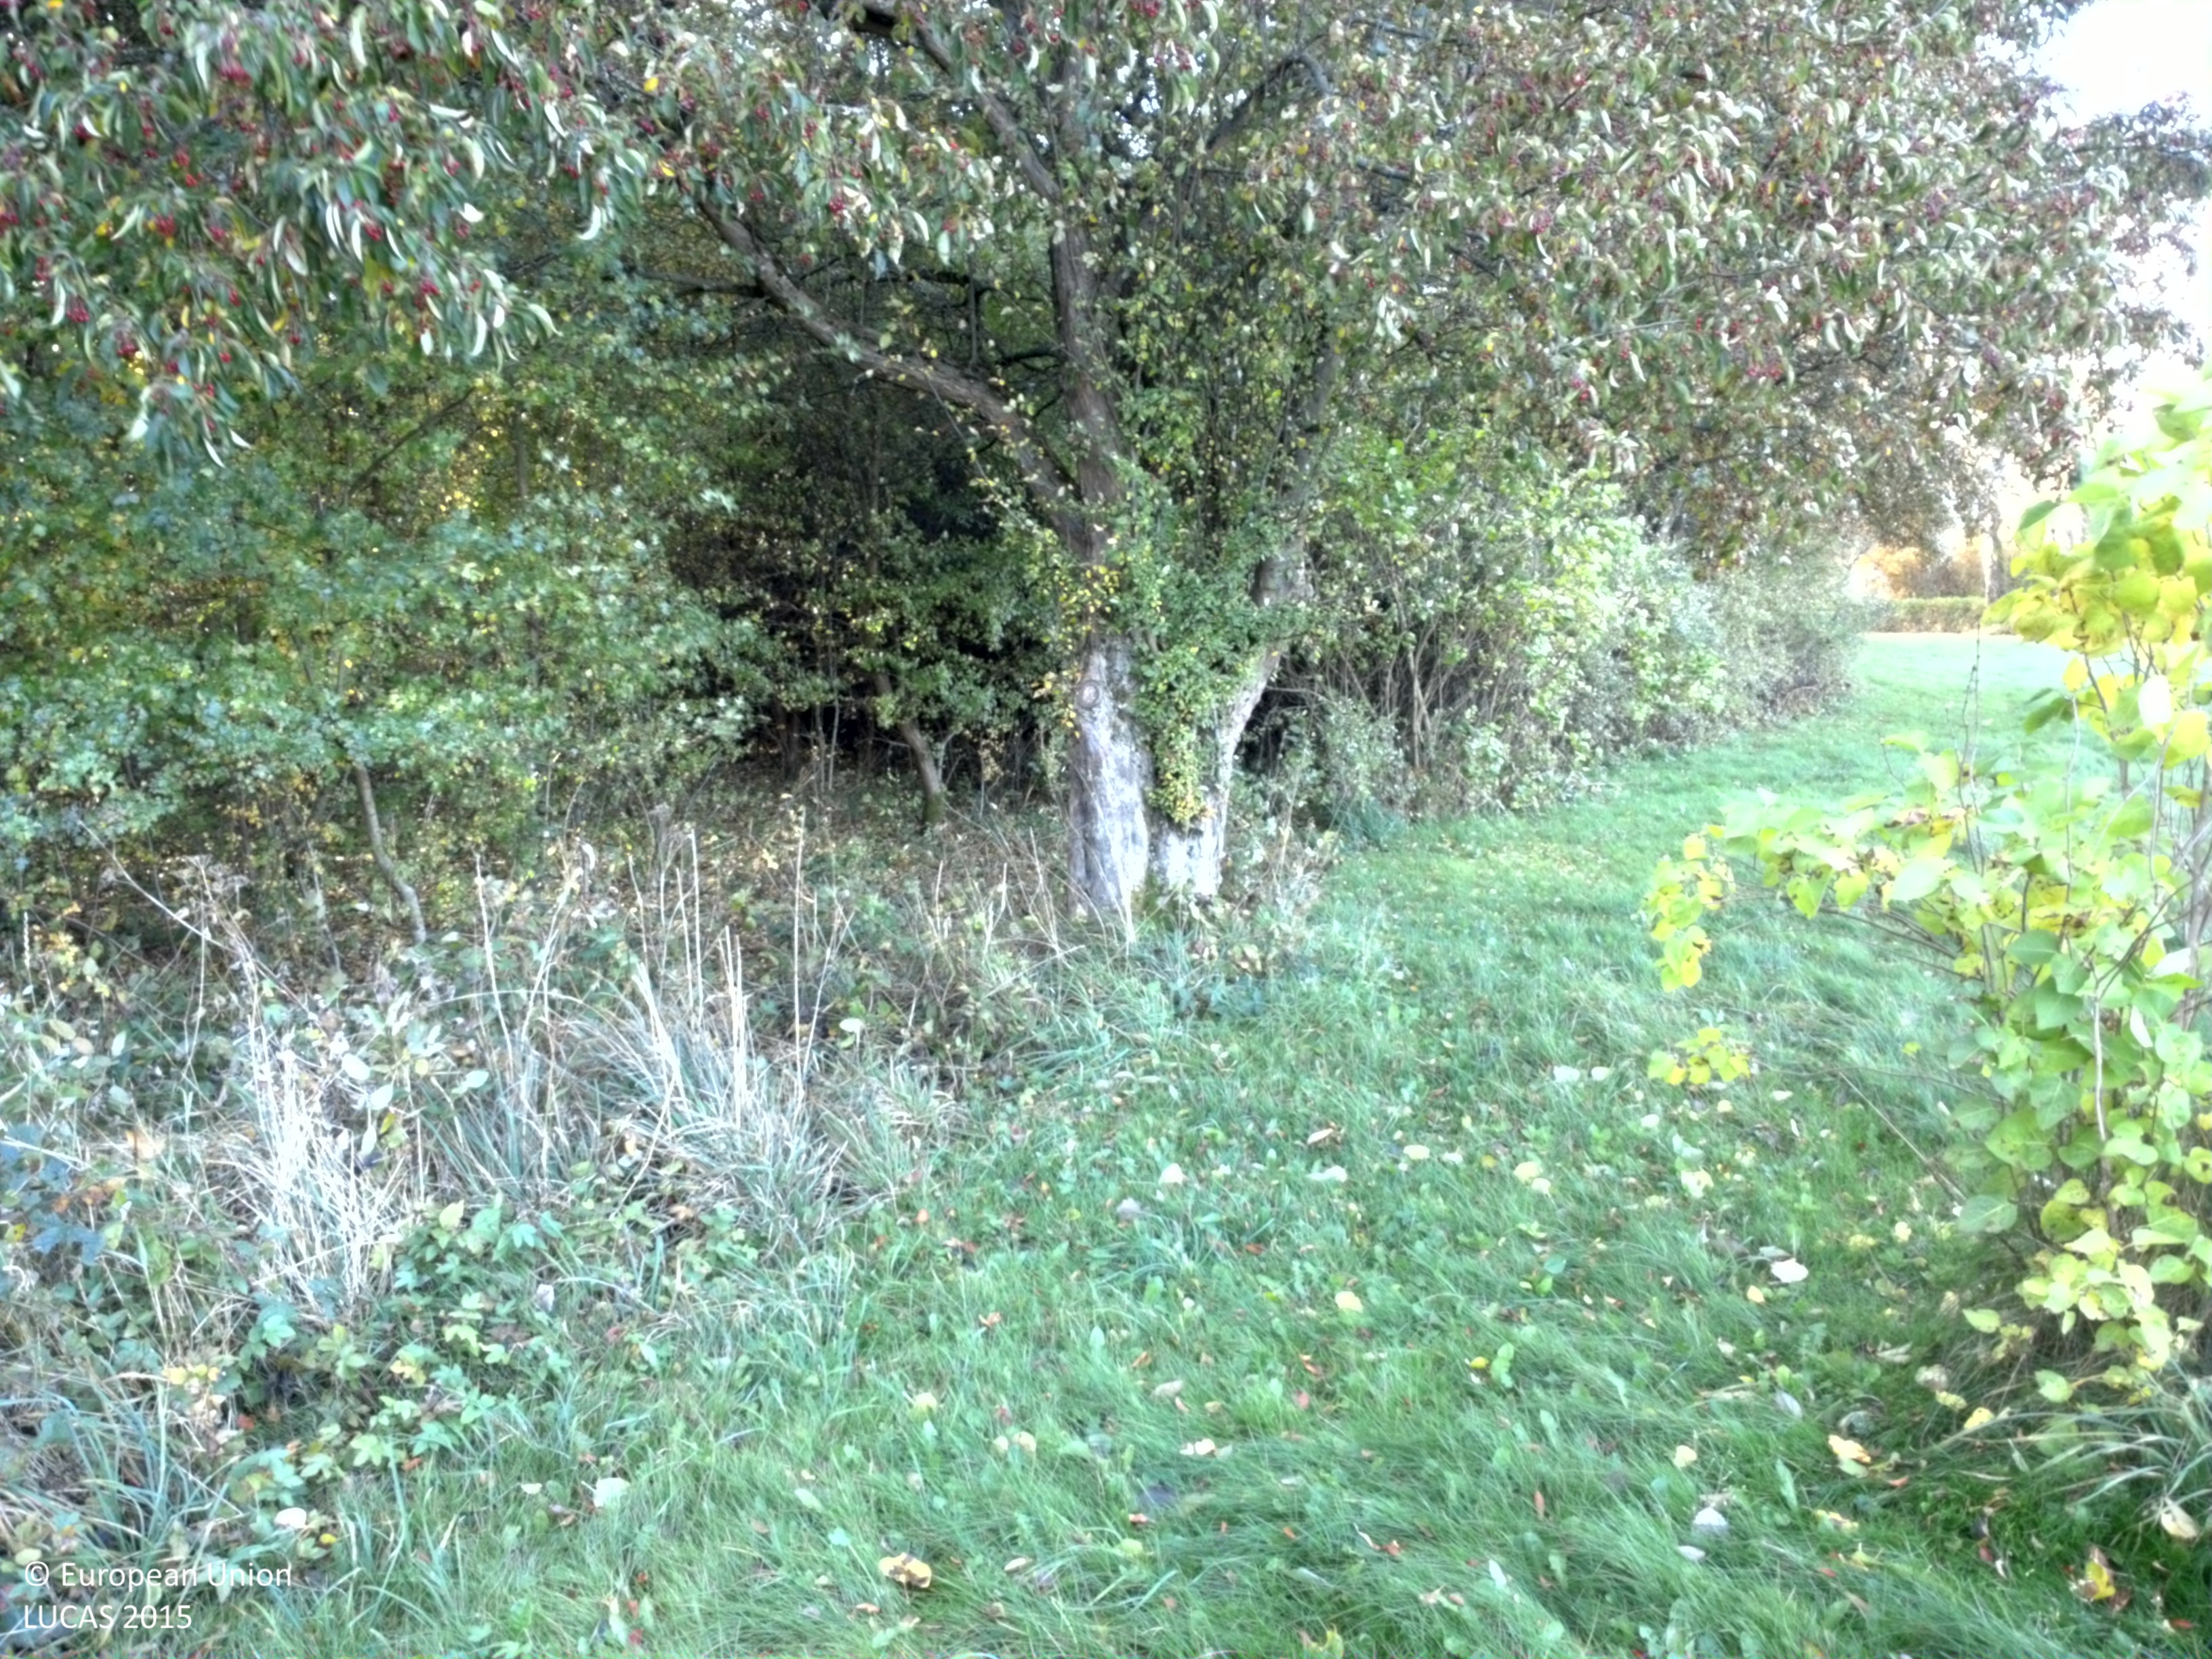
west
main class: Grassland
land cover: Grassland with sparse tree/shrub cover
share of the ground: > 75 %
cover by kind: herbaceous plants 95 %, broadleaved forest trees 5 %
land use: Residential
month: October
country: SE
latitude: 55.9348
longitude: 13.0872
